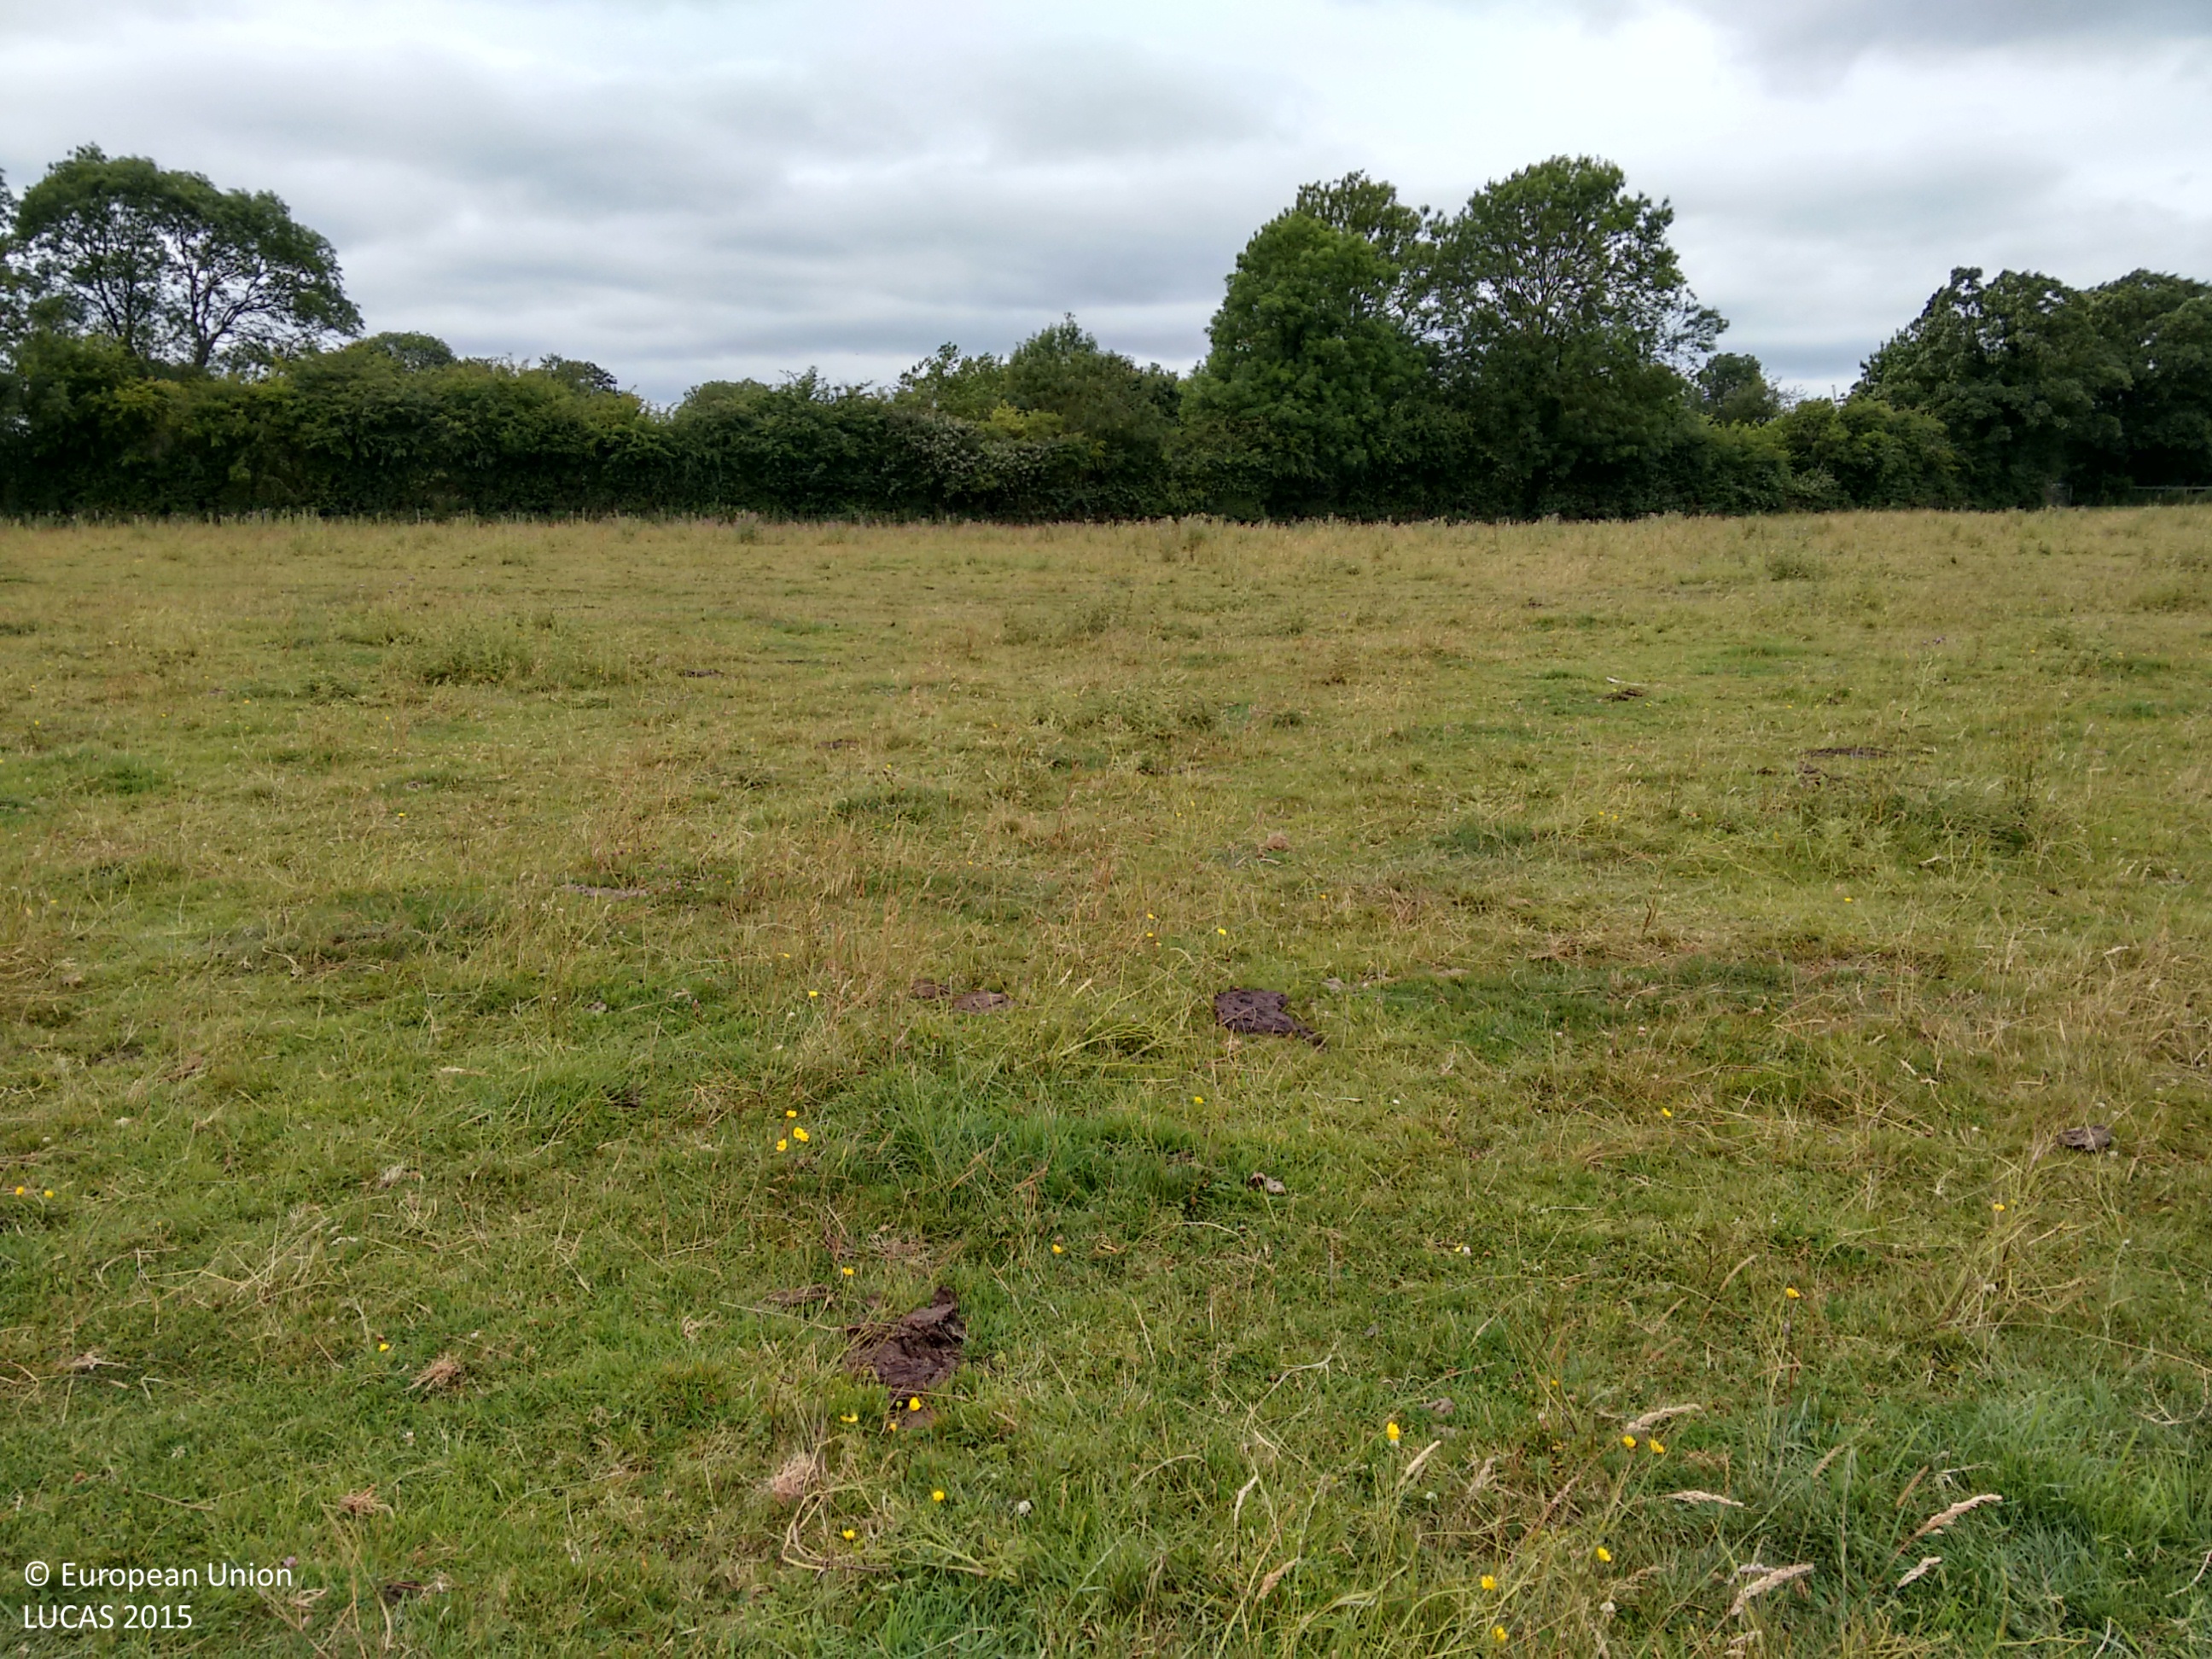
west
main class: Grassland
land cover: Grassland without tree/shrub cover
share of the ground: > 75 %
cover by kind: herbaceous plants 100 %
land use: Agriculture (excluding fallow land and kitchen gardens)
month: July
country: GB
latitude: 52.4912
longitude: -0.8973
